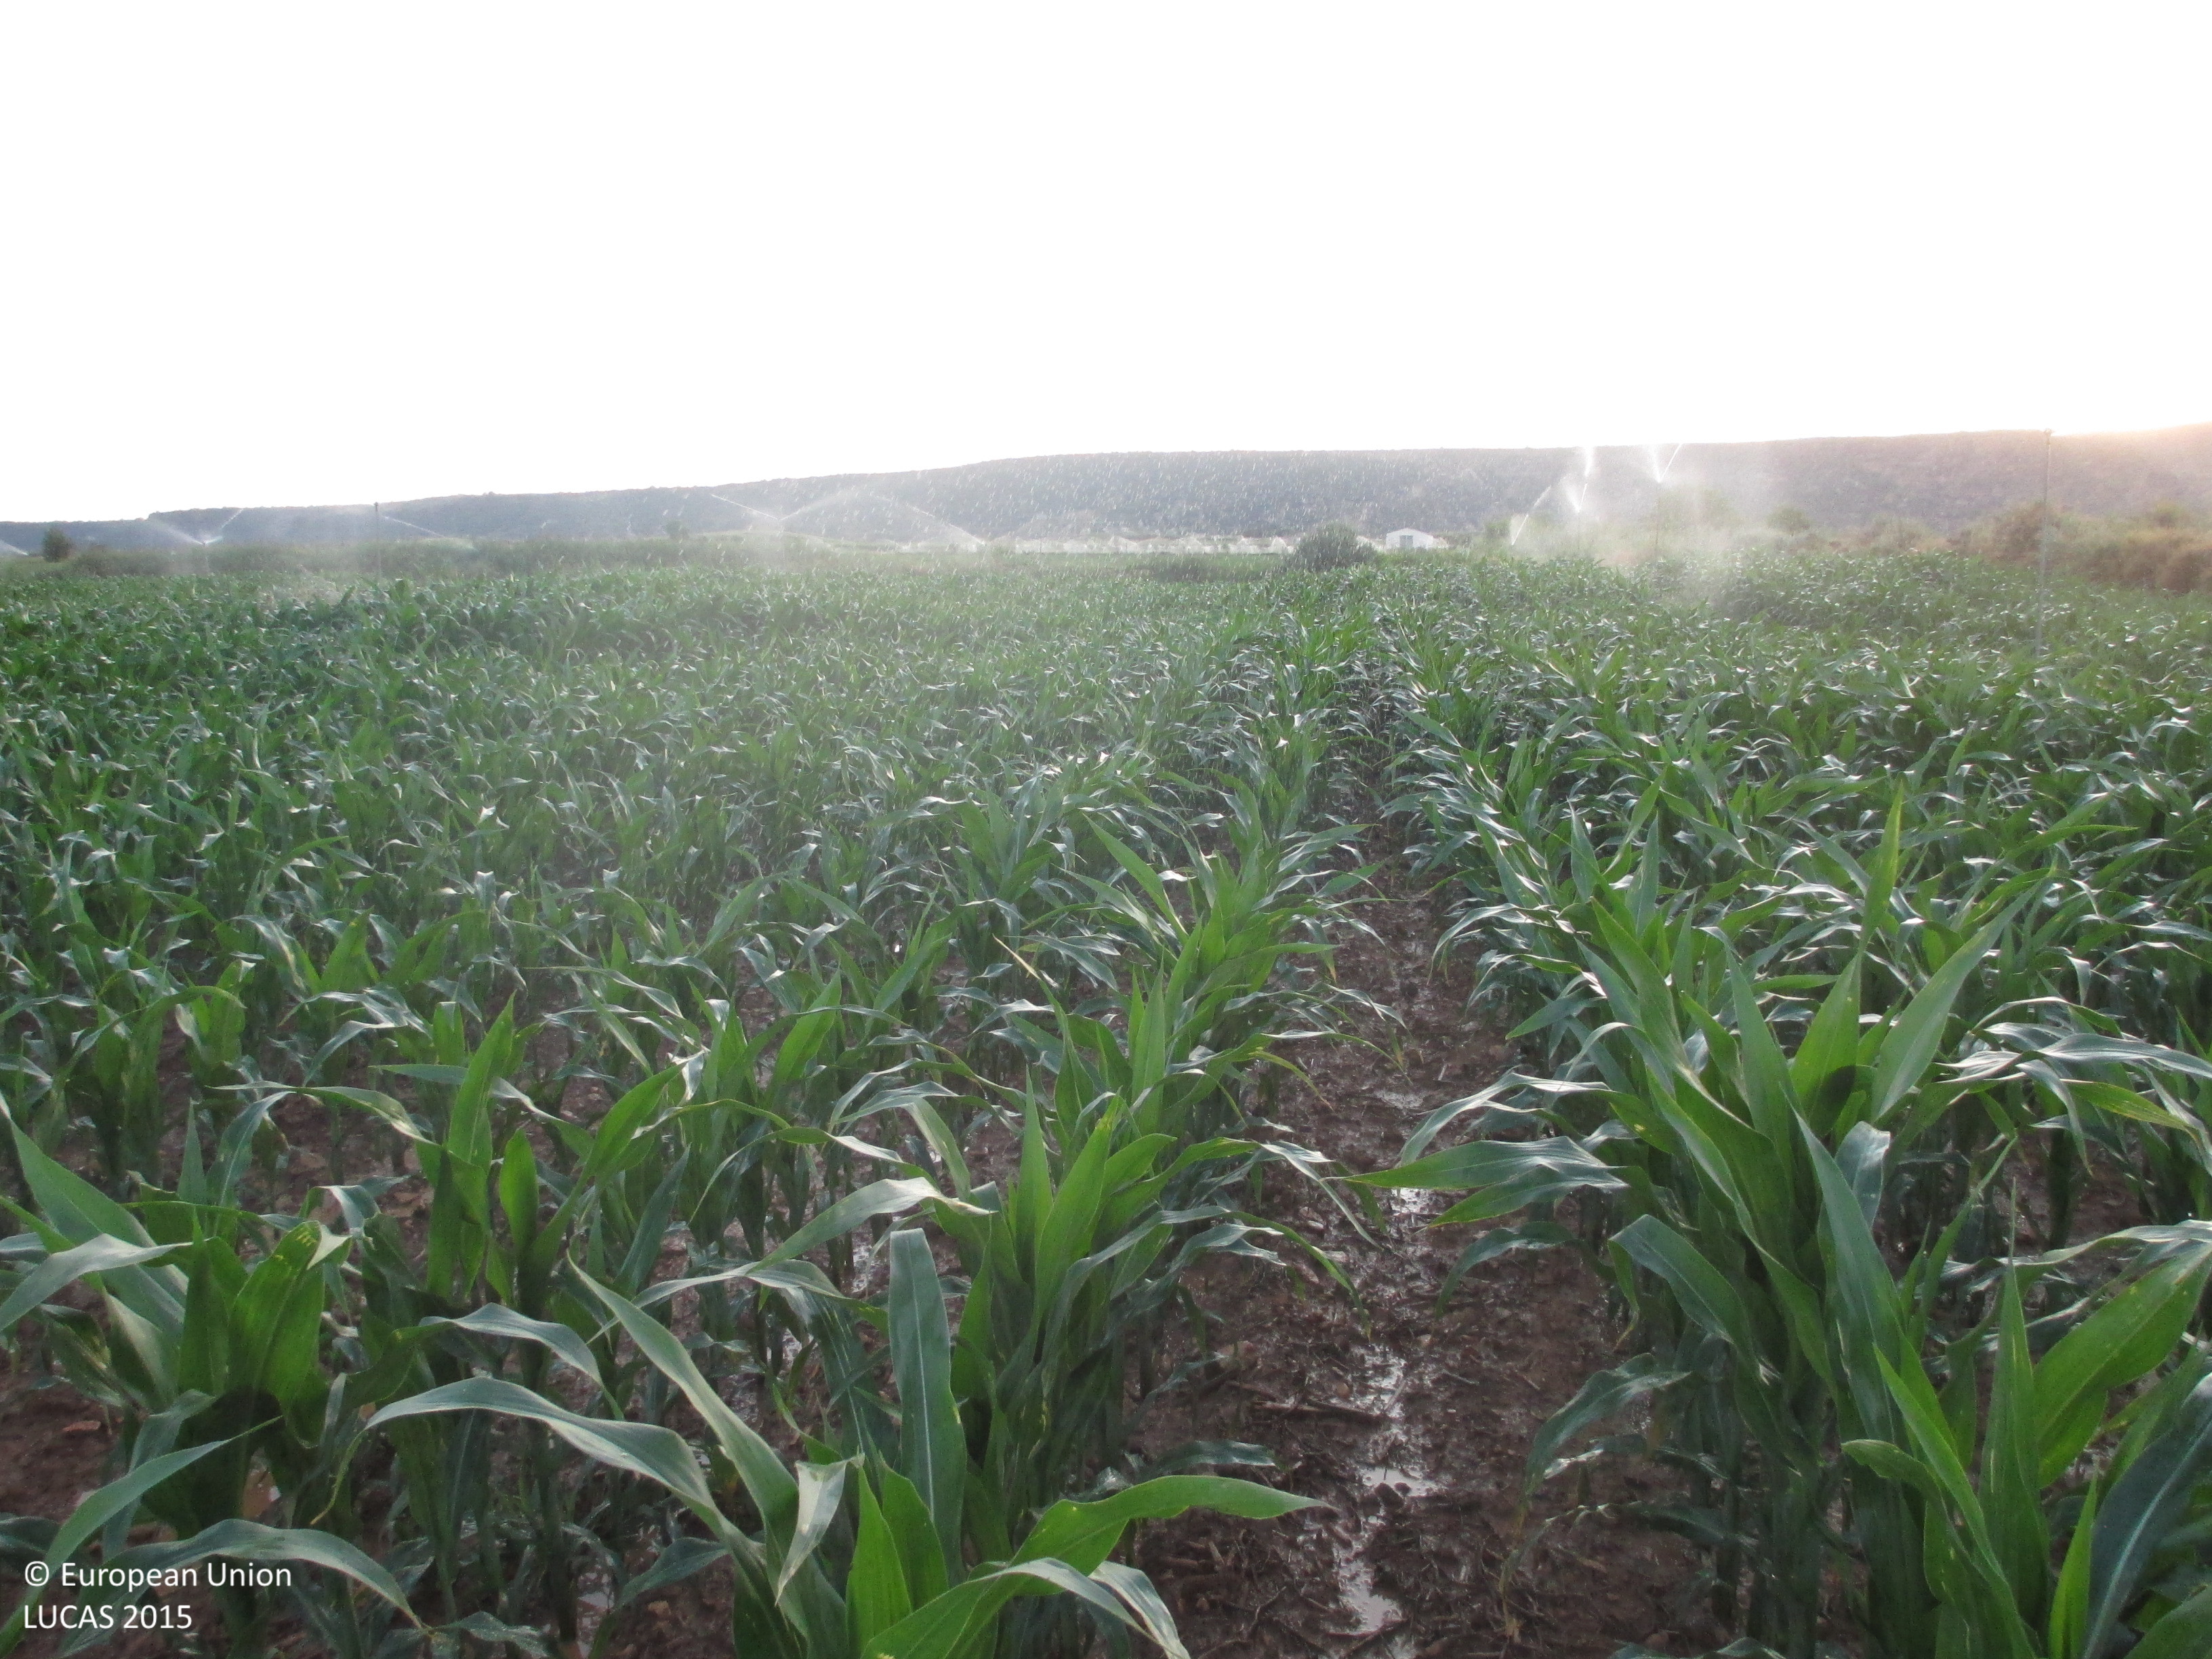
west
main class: Cropland
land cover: Maize
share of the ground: > 75 %
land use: Agriculture (excluding fallow land and kitchen gardens)
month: July
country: ES
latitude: 41.8891
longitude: 0.0396
